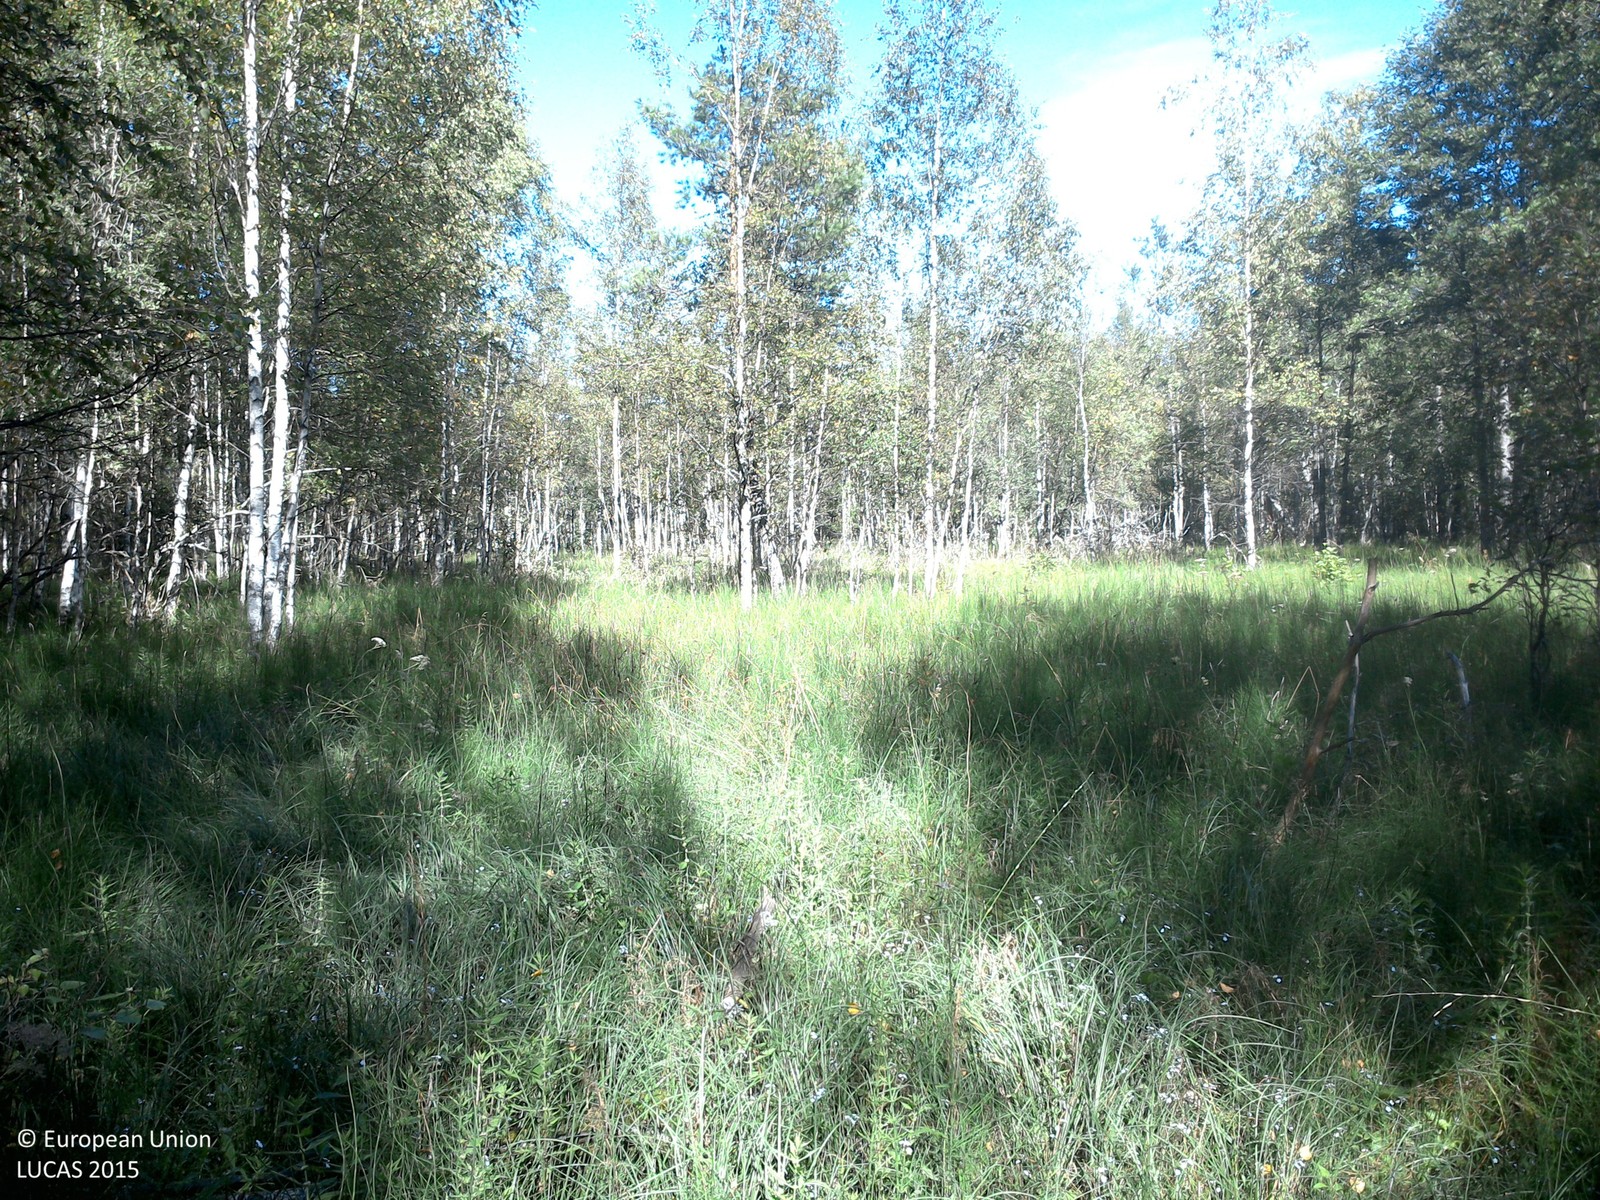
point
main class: Woodland
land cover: Broadleaved woodland
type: mire and swamp forests
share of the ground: 25 - 50 %
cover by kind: herbaceous plants 70 %, broadleaved forest trees 30 %
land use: Forestry
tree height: > 5 m
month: August
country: SE
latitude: 57.9108
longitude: 15.4471
